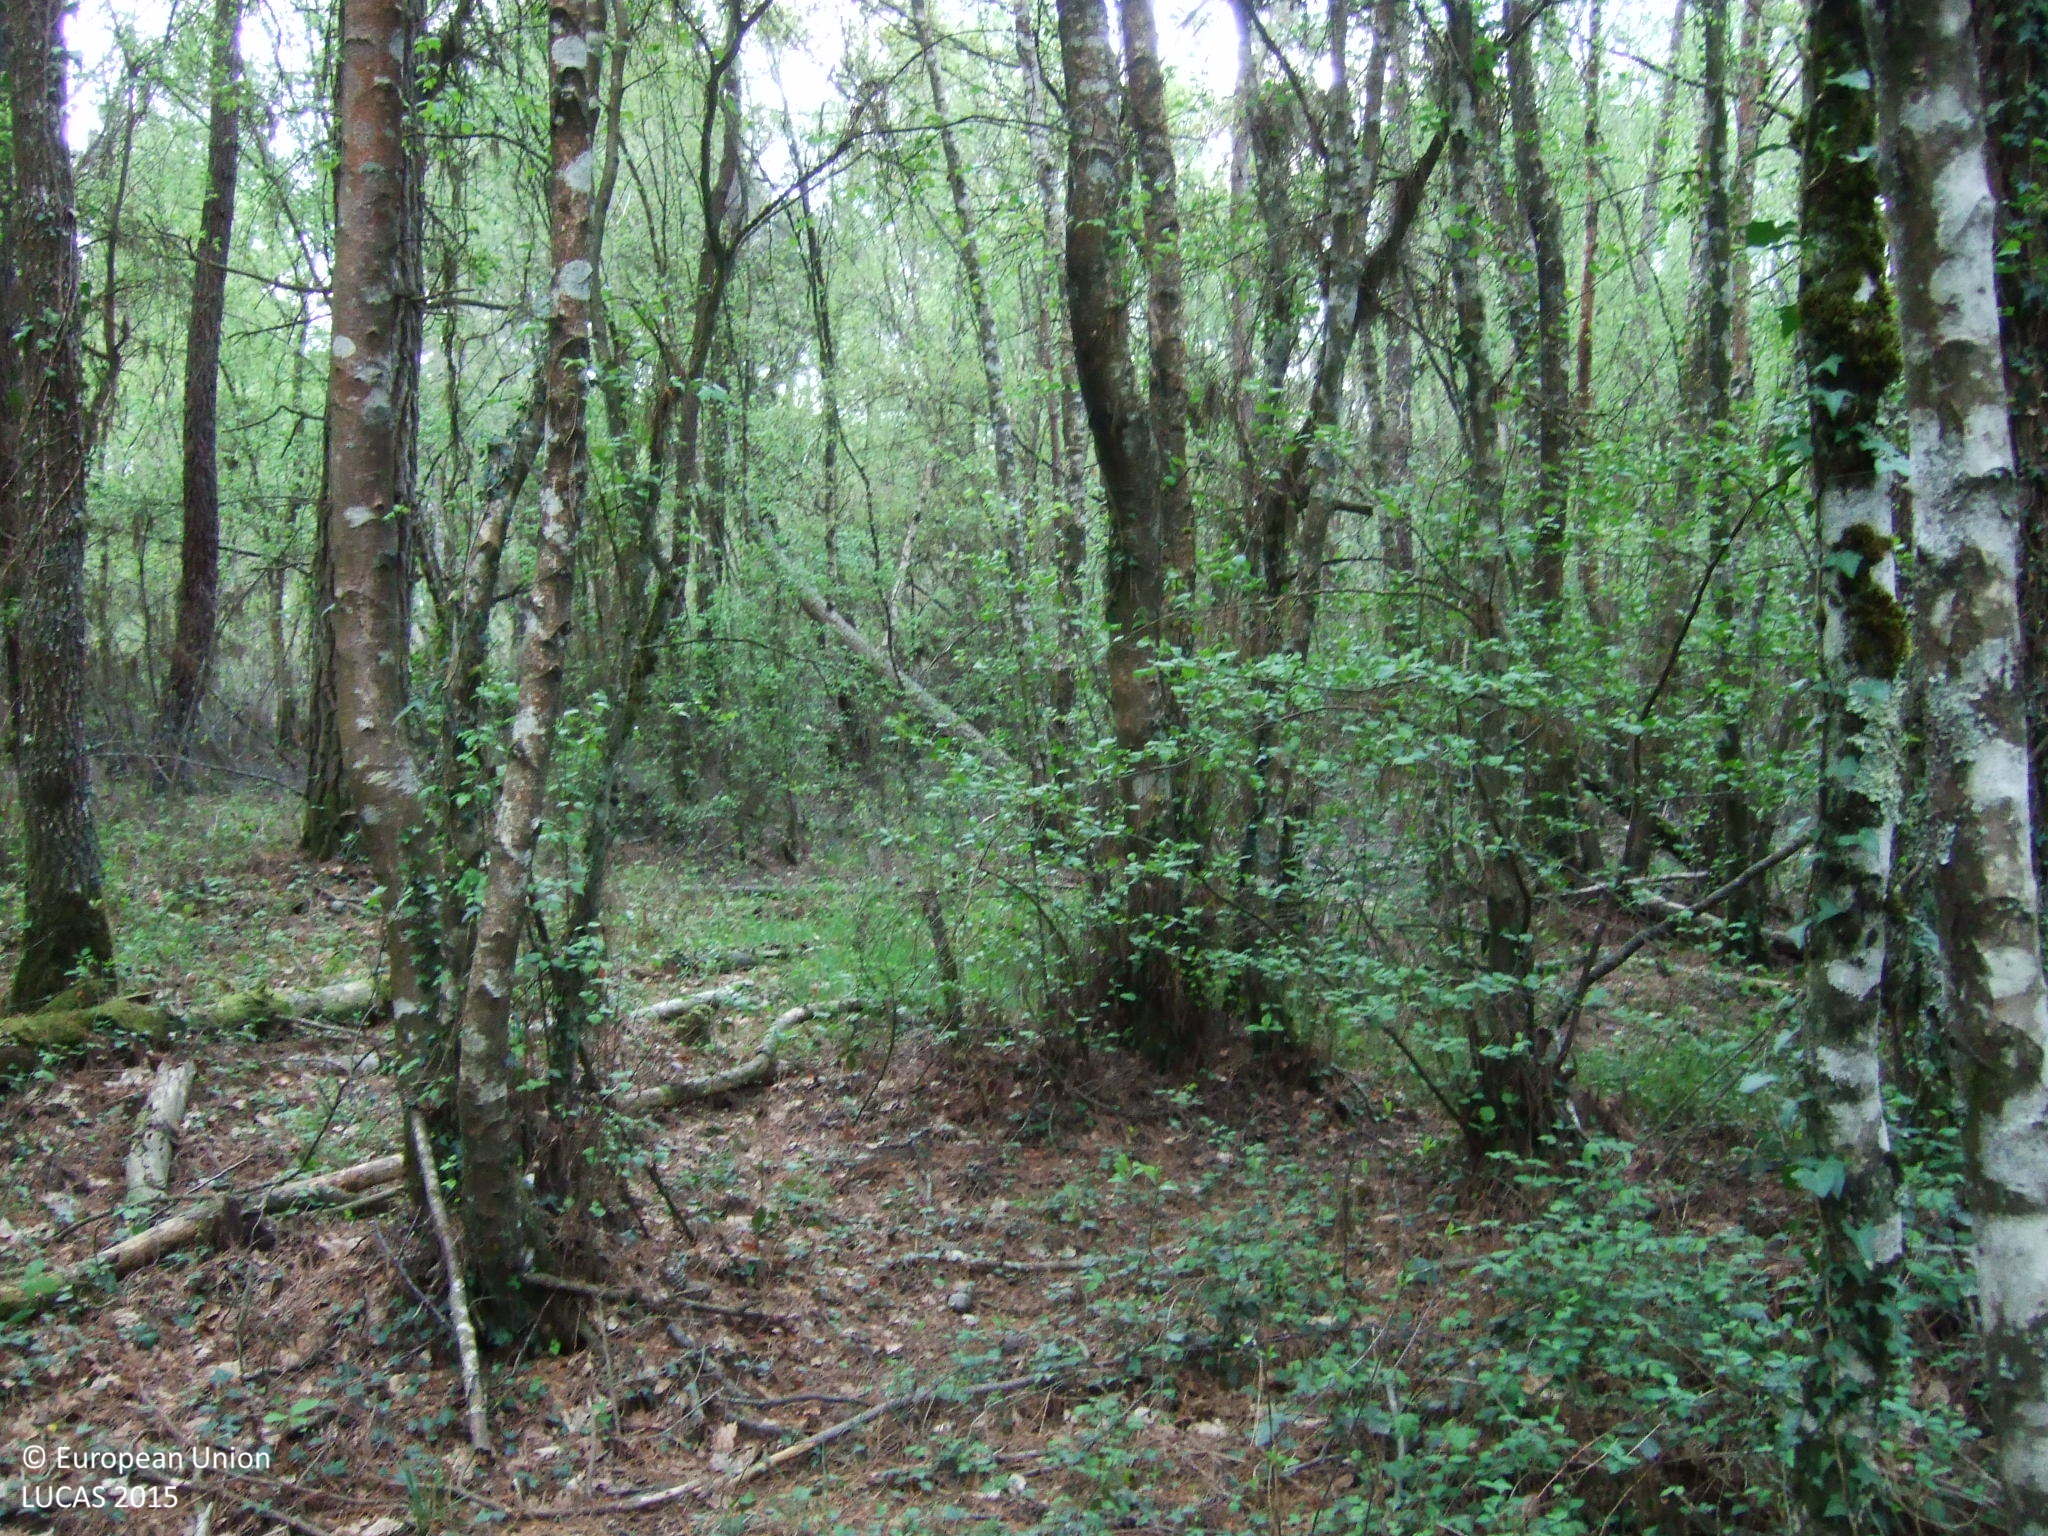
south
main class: Woodland
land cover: Other mixed woodland
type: acidophilous oak and oak-birch forest
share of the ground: > 75 %
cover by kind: broadleaved forest trees 50 %, coniferous forest trees 25 %, shrubs 25 %
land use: Forestry
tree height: > 5 m
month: April
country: ES
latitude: 43.1628
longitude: -7.7082
